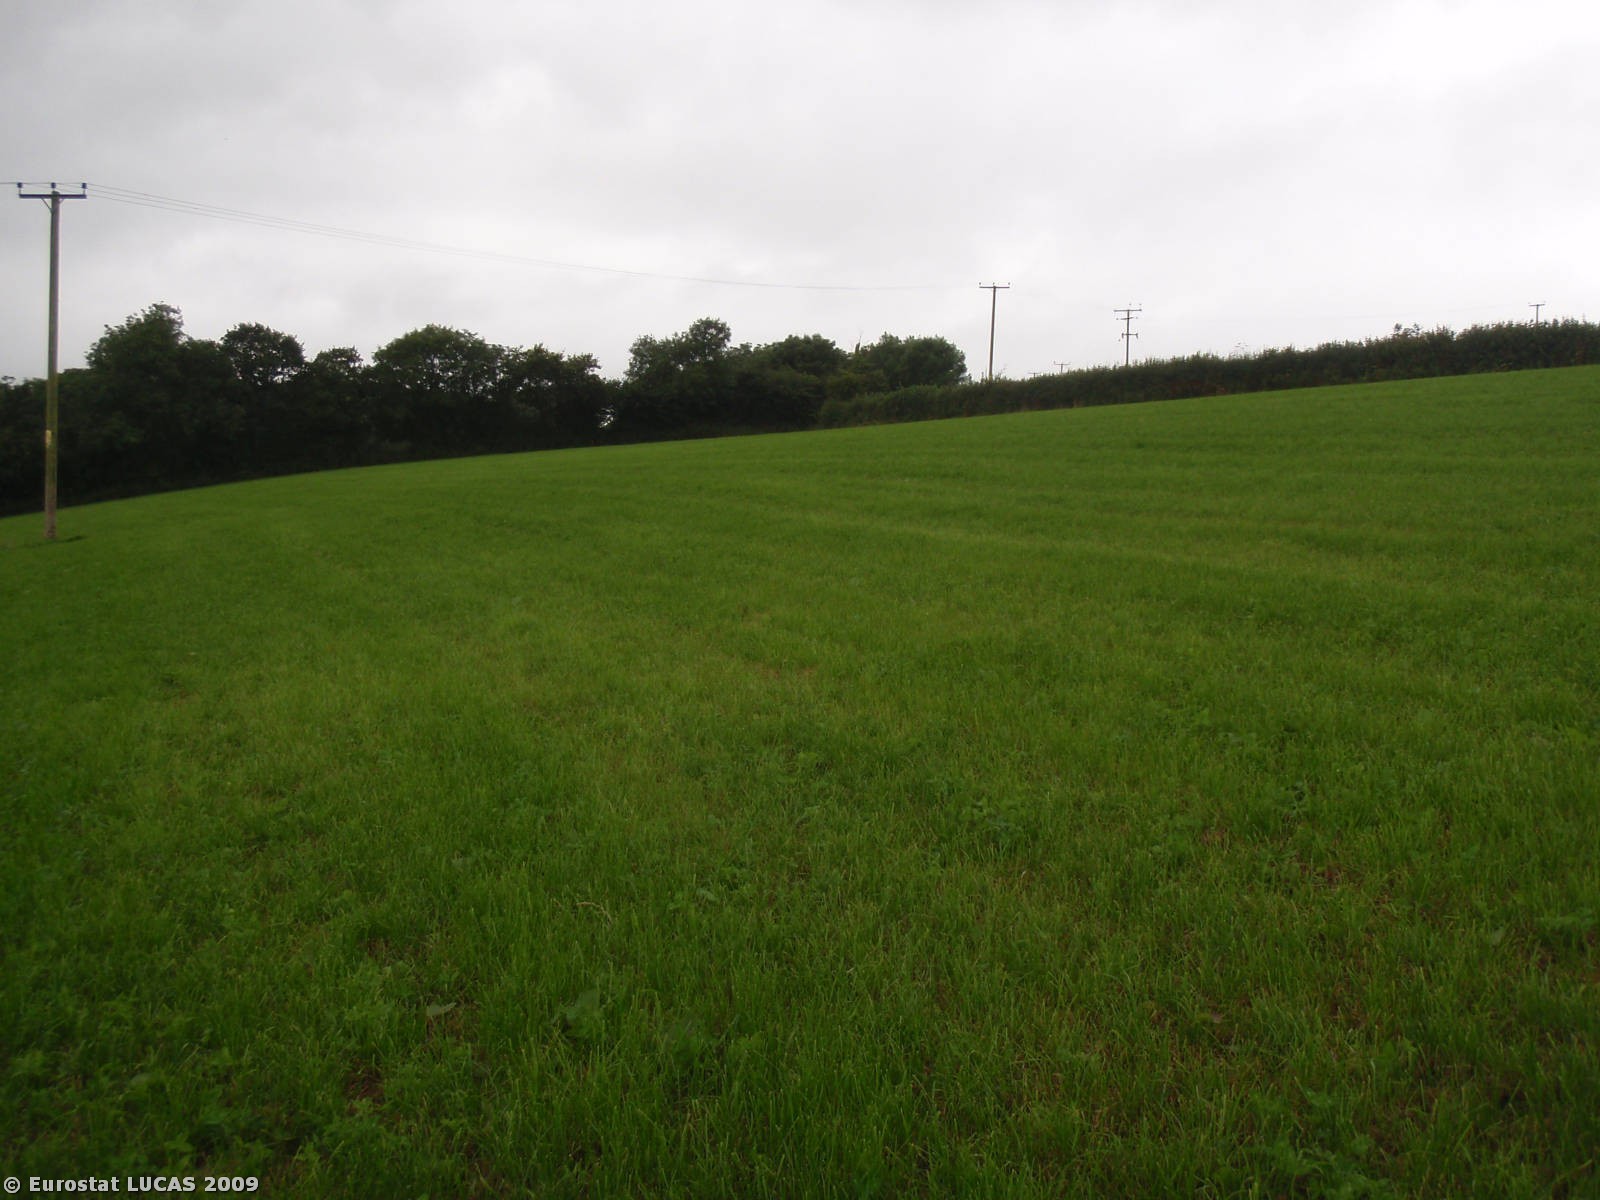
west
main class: Cropland
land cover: Clovers
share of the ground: 50 - 75 %
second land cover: Temporary grasslands
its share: 25 - 50 %
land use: Agriculture (excluding fallow land and kitchen gardens)
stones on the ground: < 10 %
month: July
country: GB
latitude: 50.7683
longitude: -4.3514
